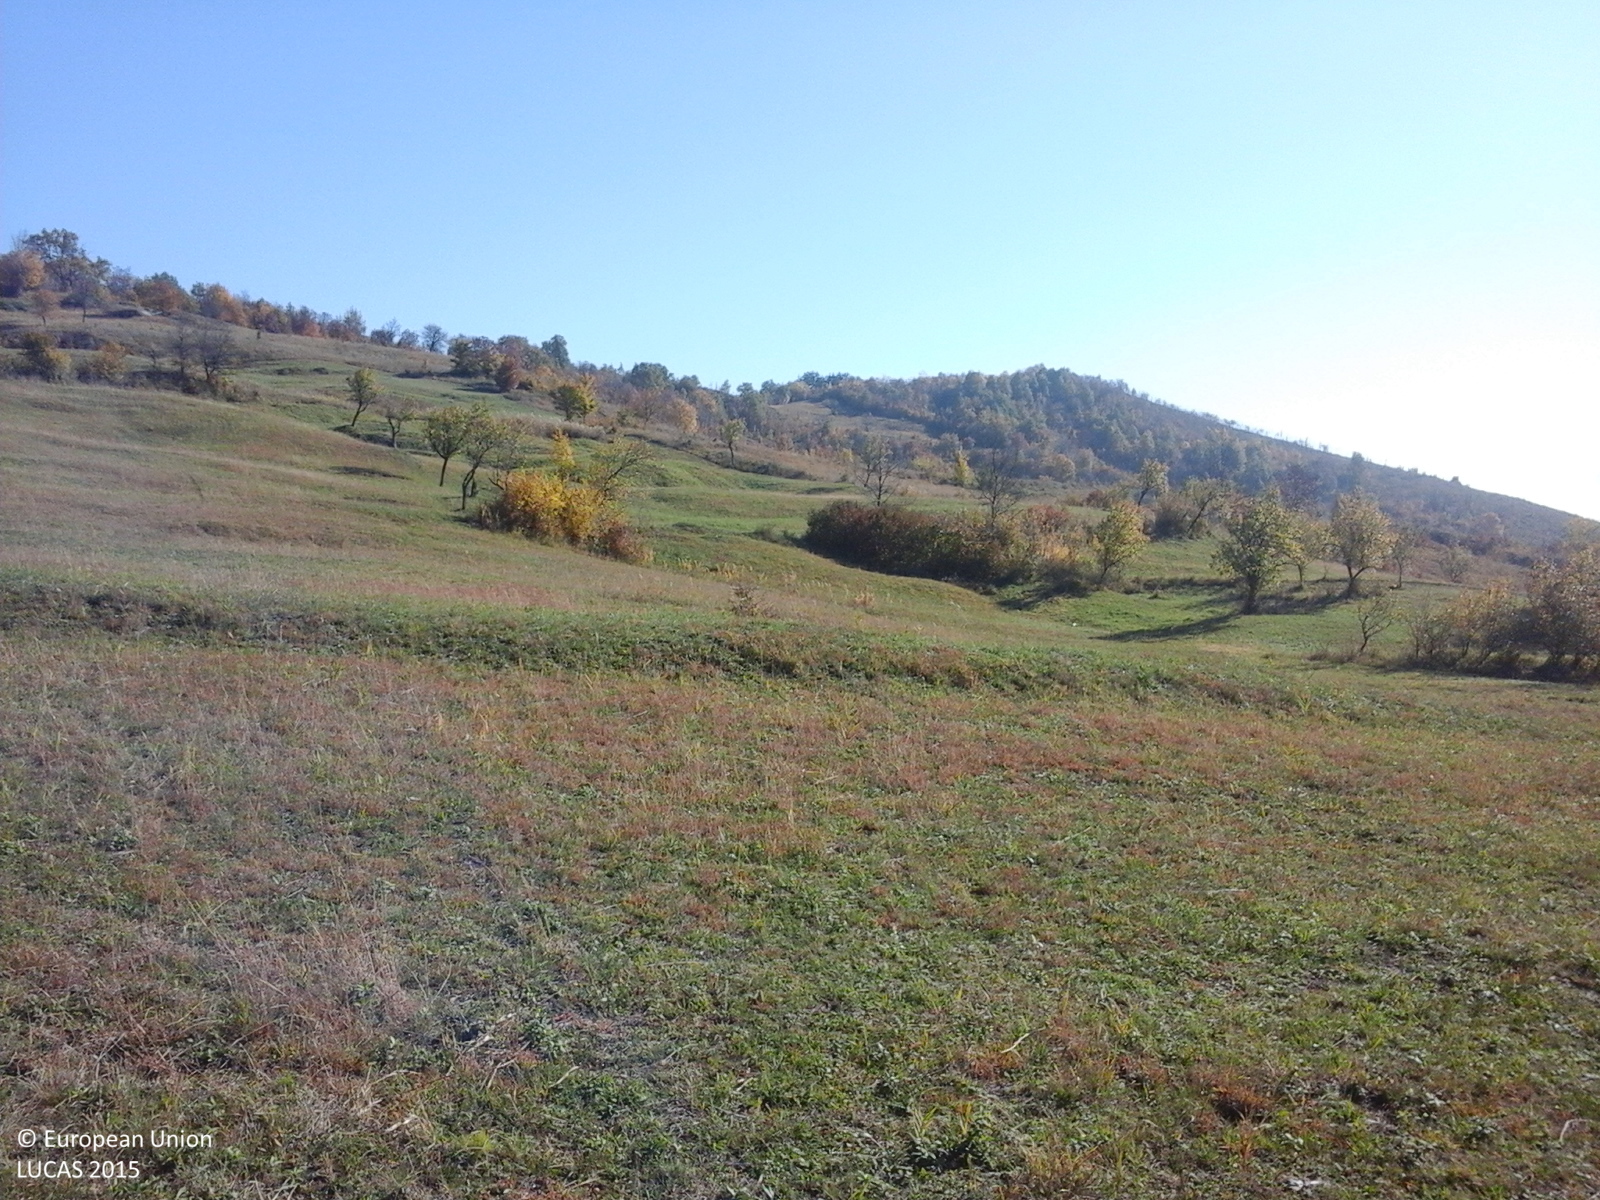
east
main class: Grassland
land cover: Grassland with sparse tree/shrub cover
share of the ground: > 75 %
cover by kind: herbaceous plants 85 %, shrubs 10 %, broadleaved forest trees 5 %
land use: Agriculture (excluding fallow land and kitchen gardens)
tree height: < 5 m
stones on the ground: < 10 %
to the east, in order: Grassland with sparse tree/shrub cover; Grassland without tree/shrub cover; Grassland with sparse tree/shrub cover
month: October
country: RO
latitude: 45.3133
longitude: 26.5150
